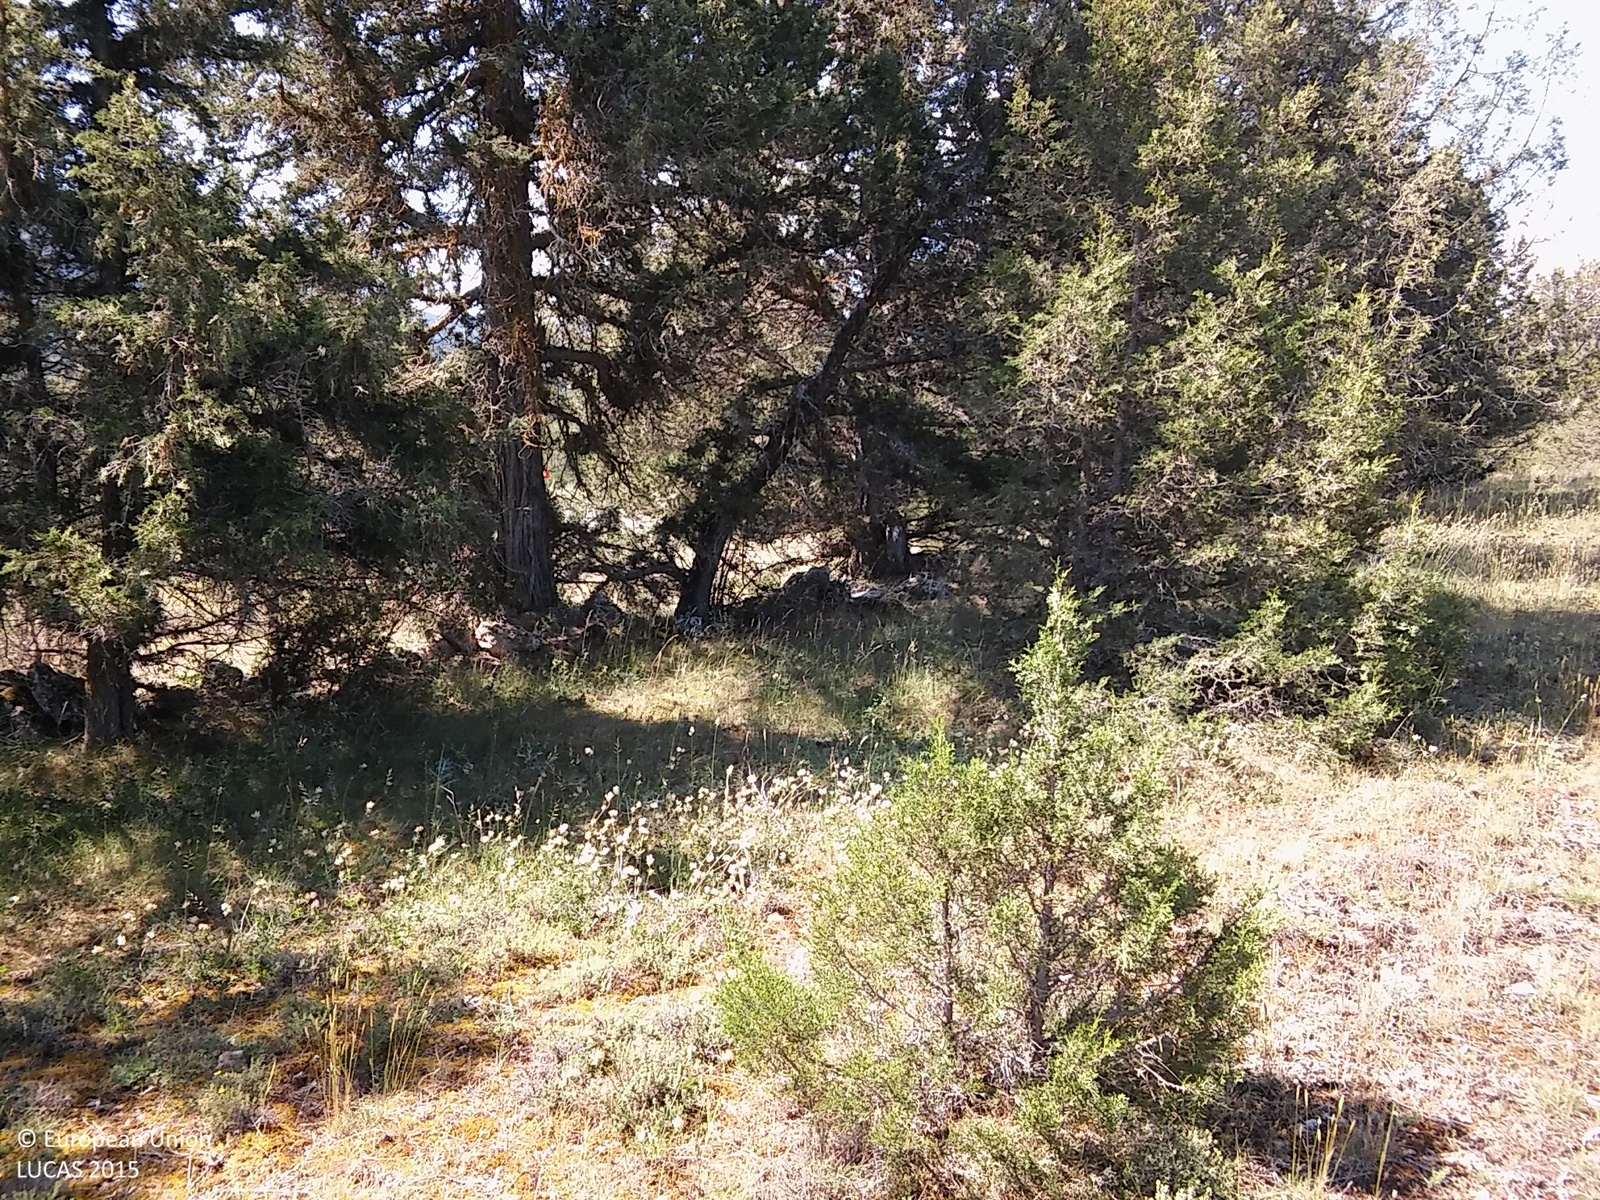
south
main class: Woodland
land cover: Other coniferous woodland
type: coniferous forest of the mediterranean region
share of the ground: 25 - 50 %
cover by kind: shrubs 30 %, coniferous forest trees 25 %, lichens and mosses 25 %, herbaceous plants 10 %, unconsolidated bare surface 10 %
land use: Forestry
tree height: > 5 m
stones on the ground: 10 - 25 %
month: June
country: ES
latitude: 41.1555
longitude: -3.6669
